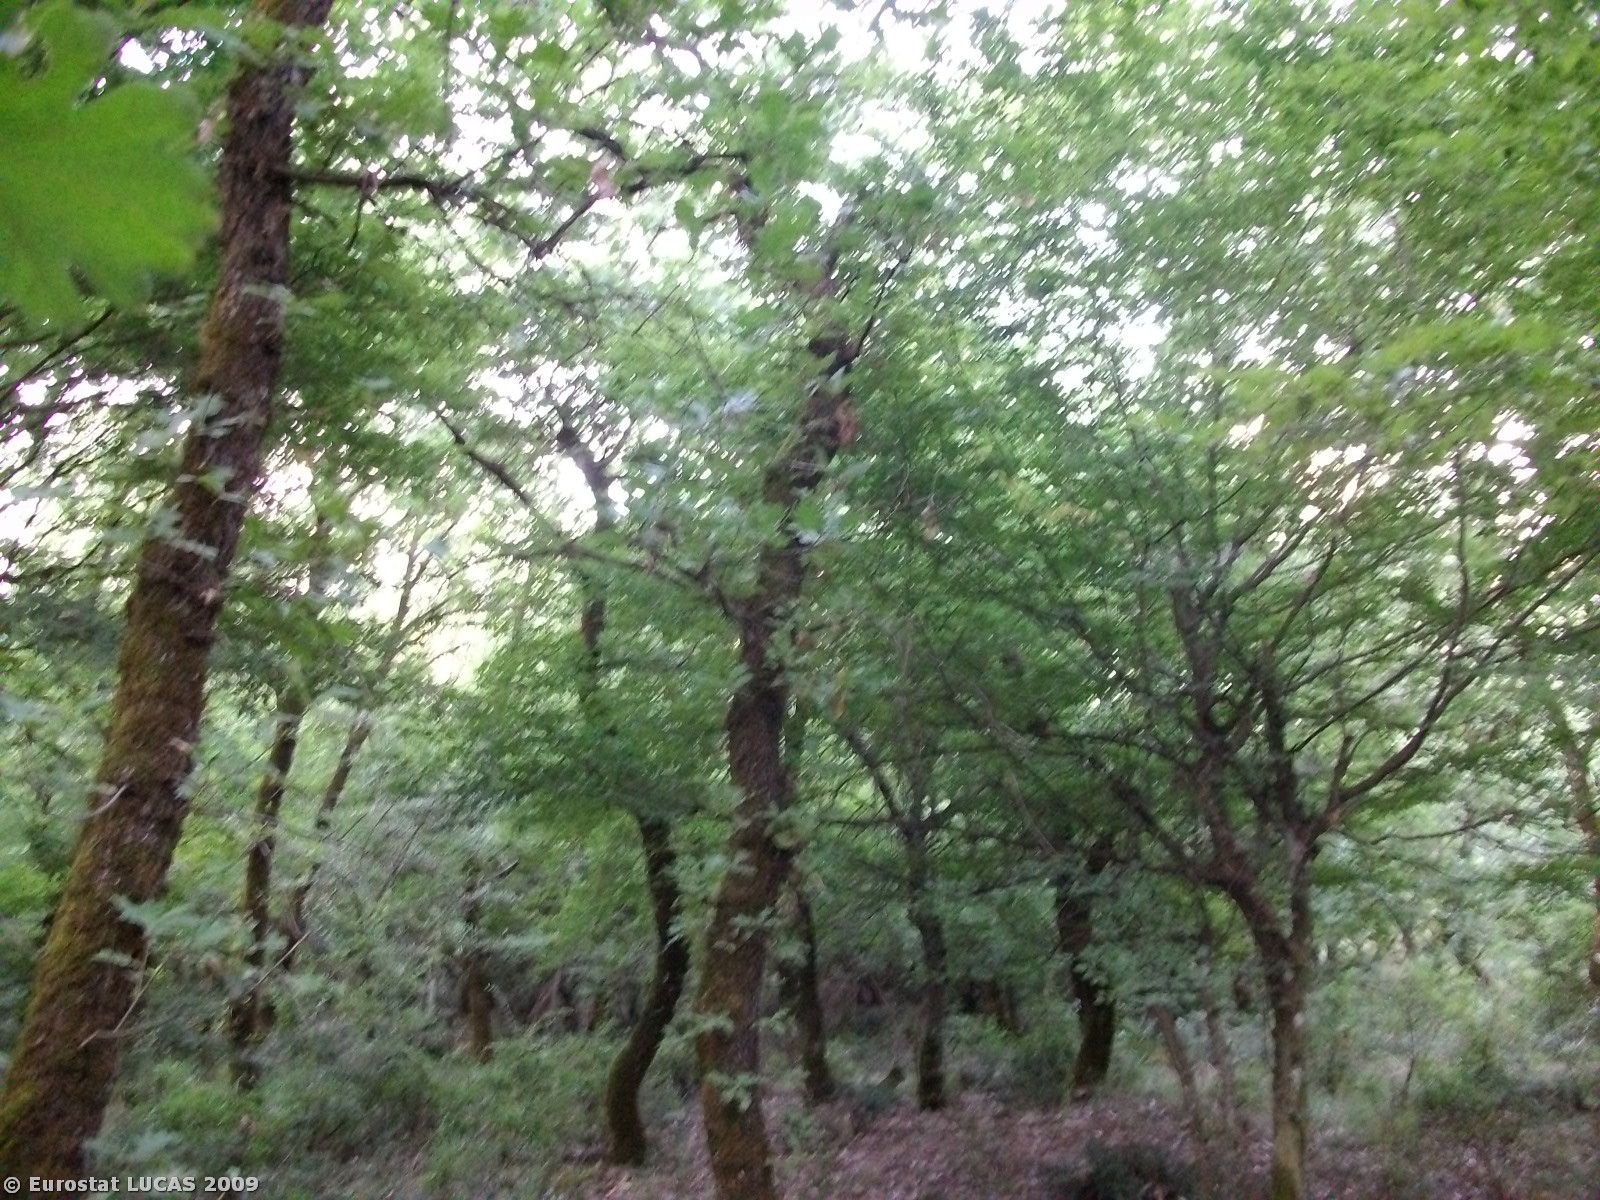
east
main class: Woodland
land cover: Broadleaved woodland
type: broadleaved evergreen forest
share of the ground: > 75 %
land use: Forestry
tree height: > 5 m
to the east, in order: Broadleaved woodland; Grassland with sparse tree/shrub cover; Abandoned hedges; Tracks; Abandoned hedges; Grassland without tree/shrub cover
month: July
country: GR
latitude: 39.5395
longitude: 21.6059
